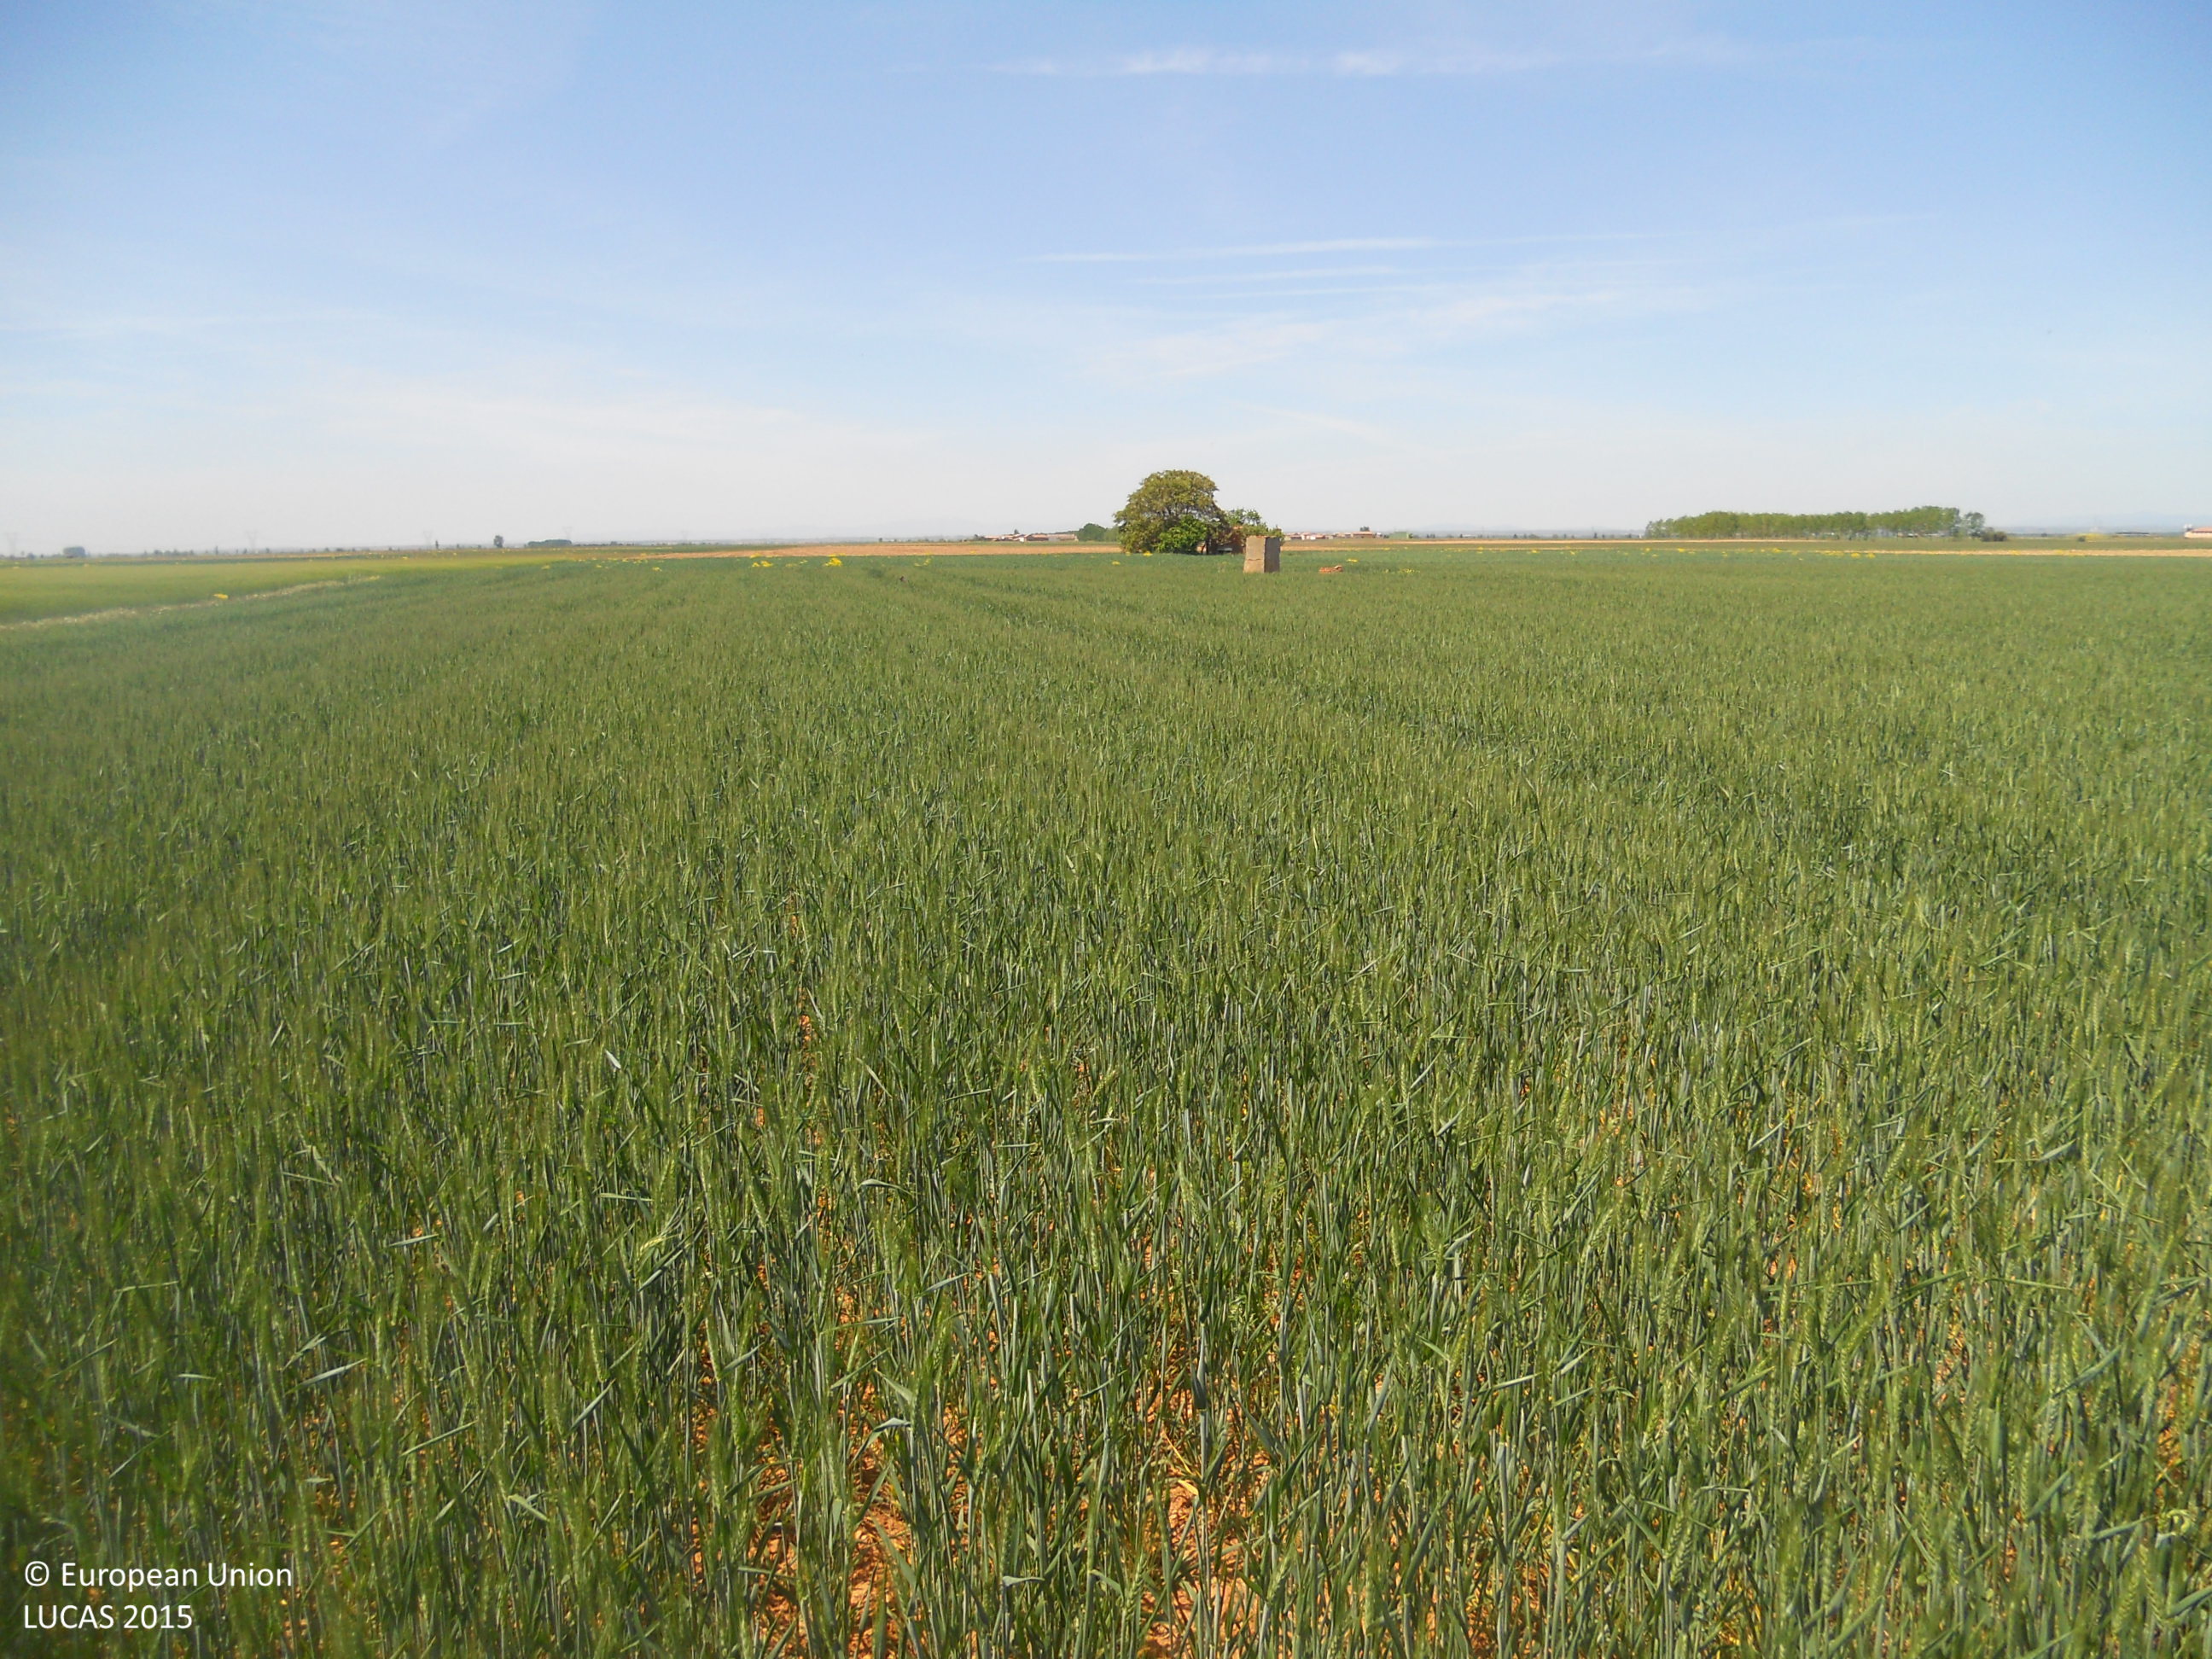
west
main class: Cropland
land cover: Durum wheat
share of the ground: > 75 %
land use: Agriculture (excluding fallow land and kitchen gardens)
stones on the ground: < 10 %
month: May
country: ES
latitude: 42.4411
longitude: -5.3974
